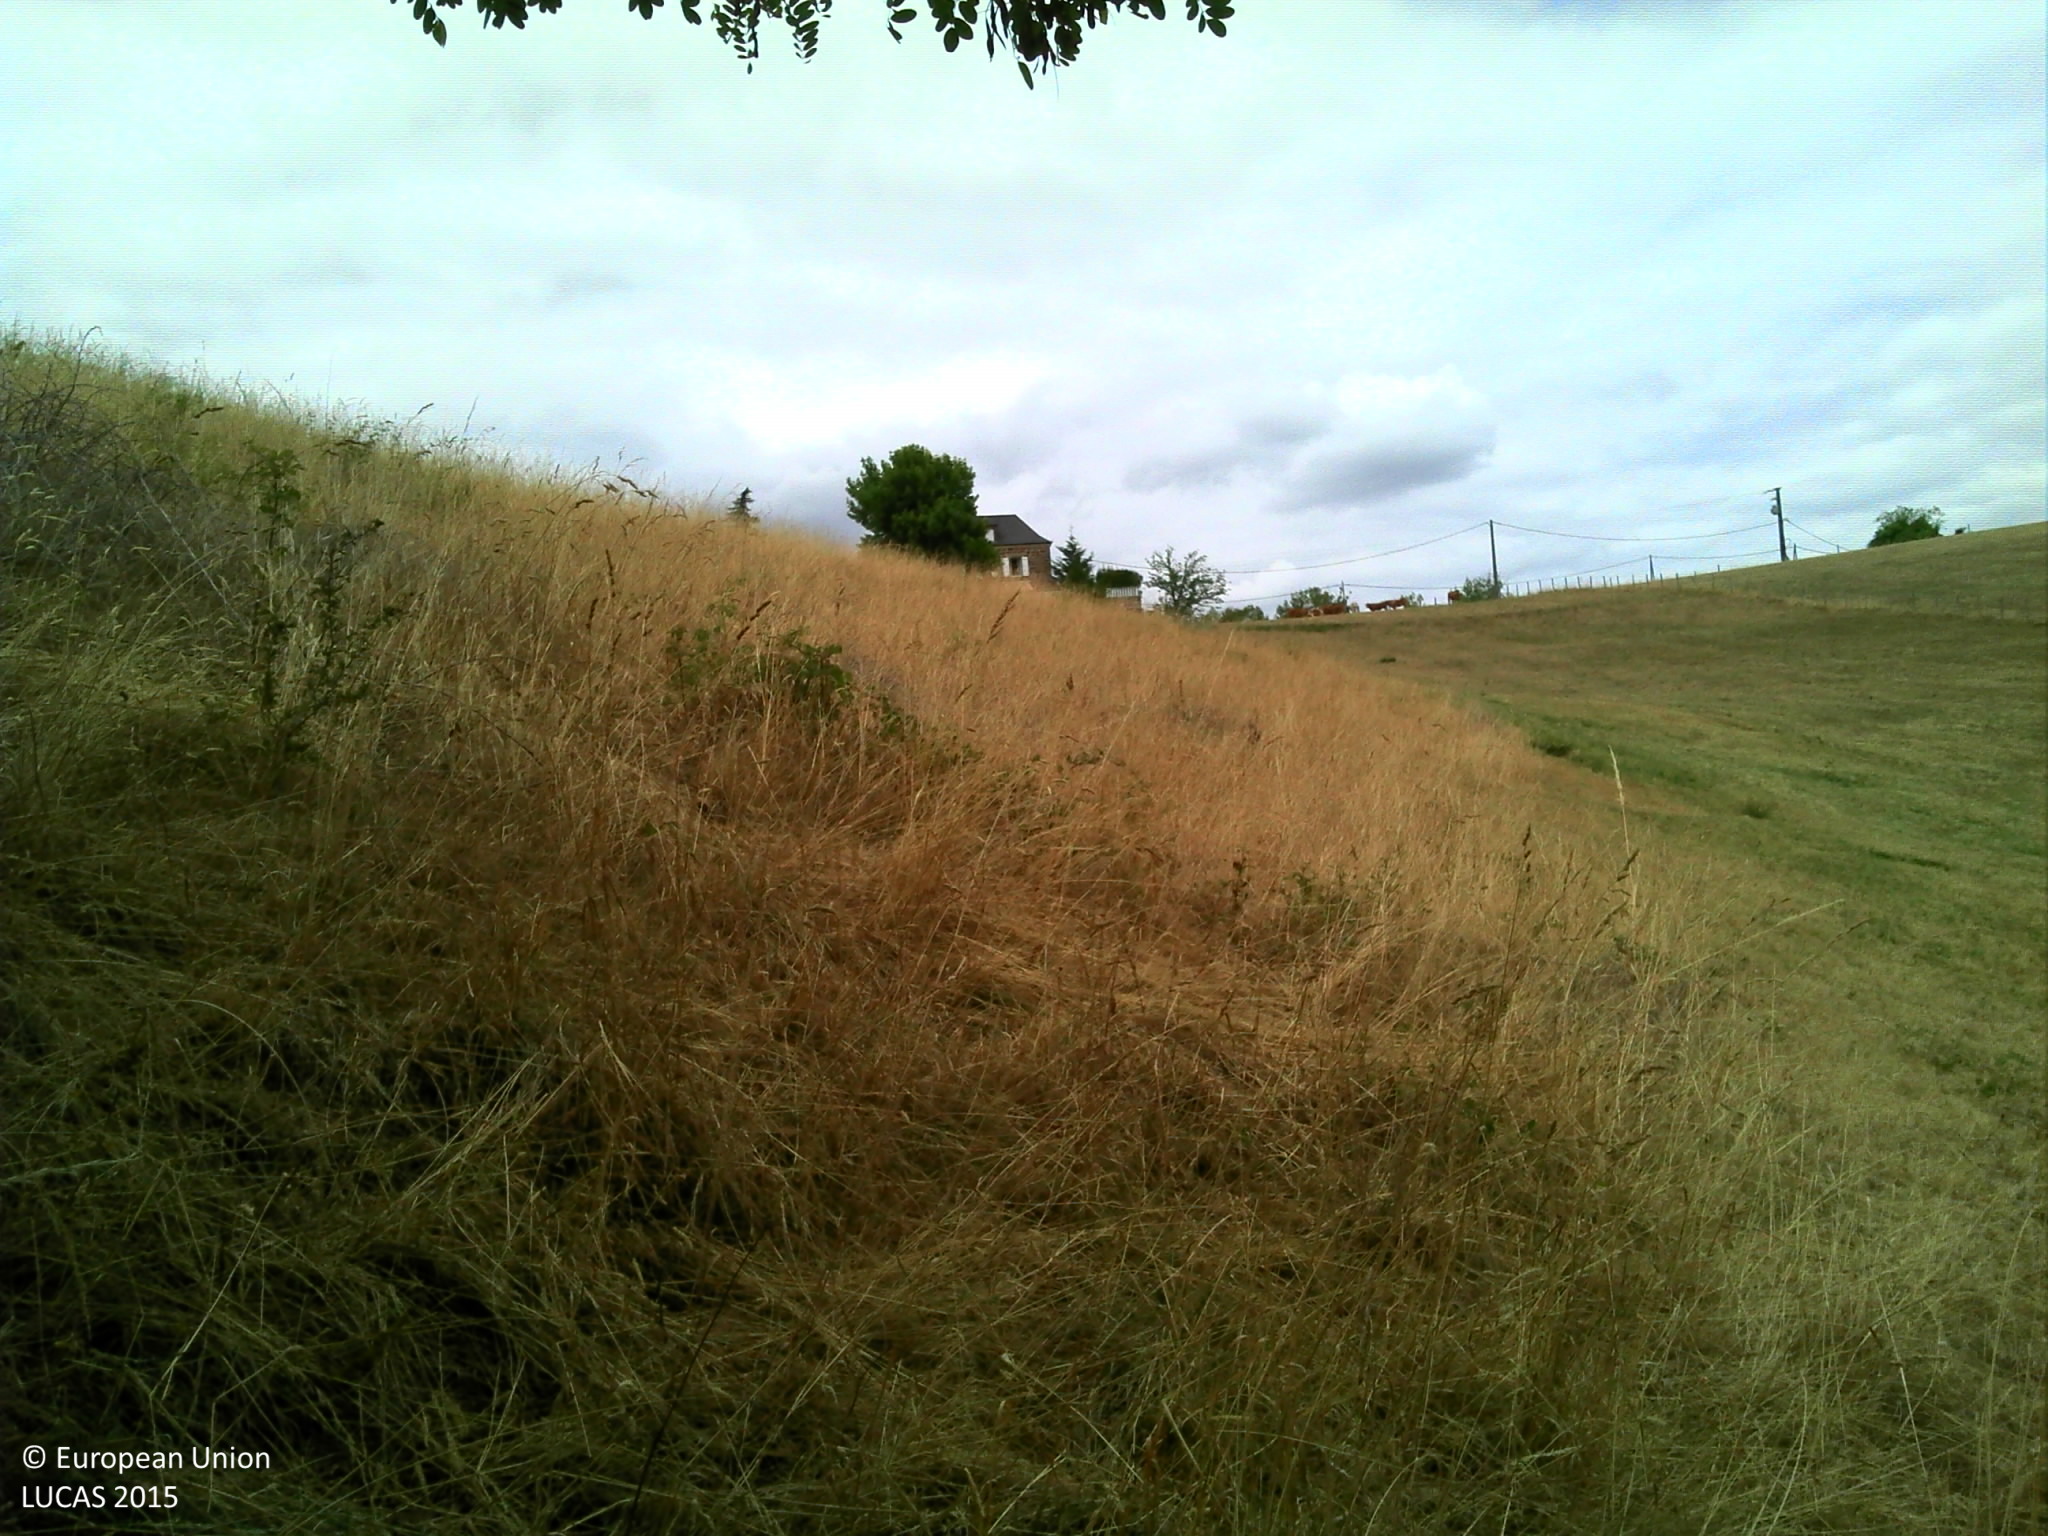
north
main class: Grassland
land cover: Grassland with sparse tree/shrub cover
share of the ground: > 75 %
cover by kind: herbaceous plants 90 %, broadleaved forest trees 5 %, lichens and mosses 5 %
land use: Agriculture (excluding fallow land and kitchen gardens)
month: July
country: FR
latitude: 45.1716
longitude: 1.4059
